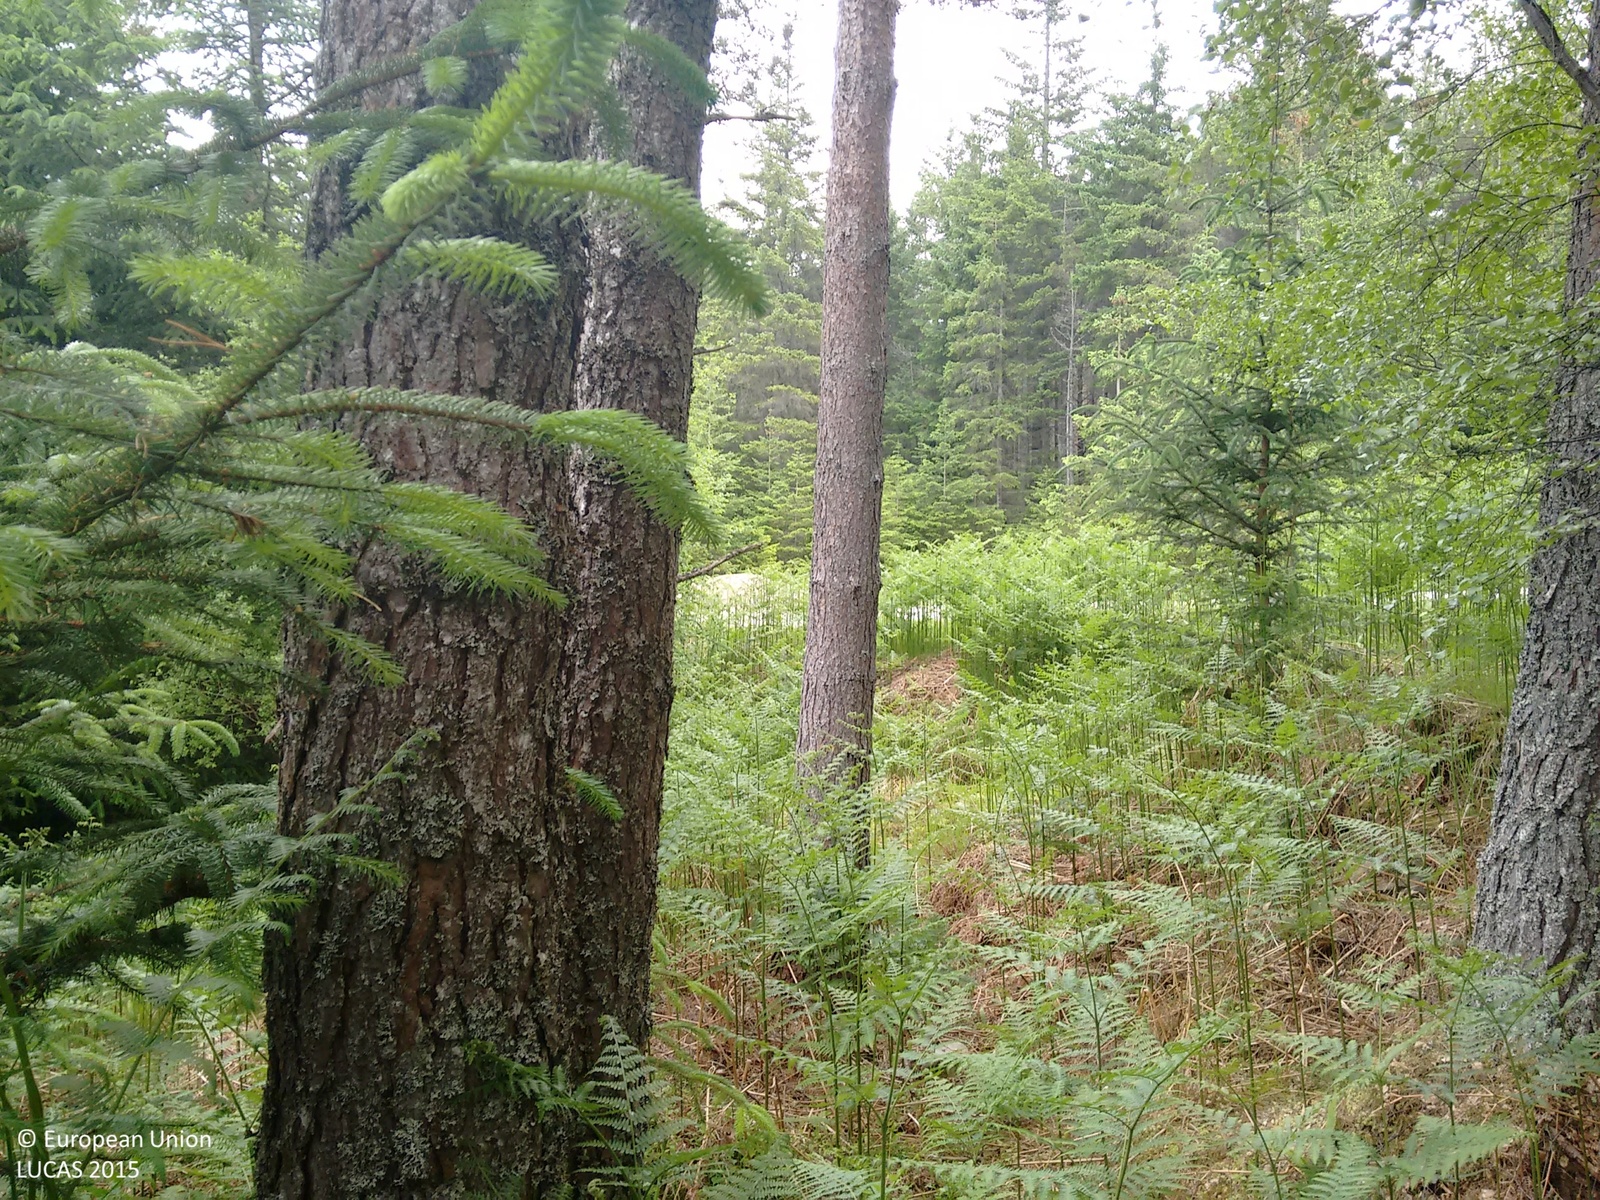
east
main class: Woodland
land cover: Spruce dominated coniferous woodland
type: exotic forest
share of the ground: > 75 %
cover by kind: coniferous forest trees 85 %, broadleaved forest trees 15 %
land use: Forestry
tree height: > 5 m
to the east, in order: Spruce dominated coniferous woodland; Grass margins; Tracks; Grass margins; Spruce dominated coniferous woodland; Pine dominated coniferous woodland; Spruce dominated coniferous woodland; Pine dominated coniferous woodland; Spruce dominated coniferous woodland
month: July
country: GB
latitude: 56.6829
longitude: -4.2758
